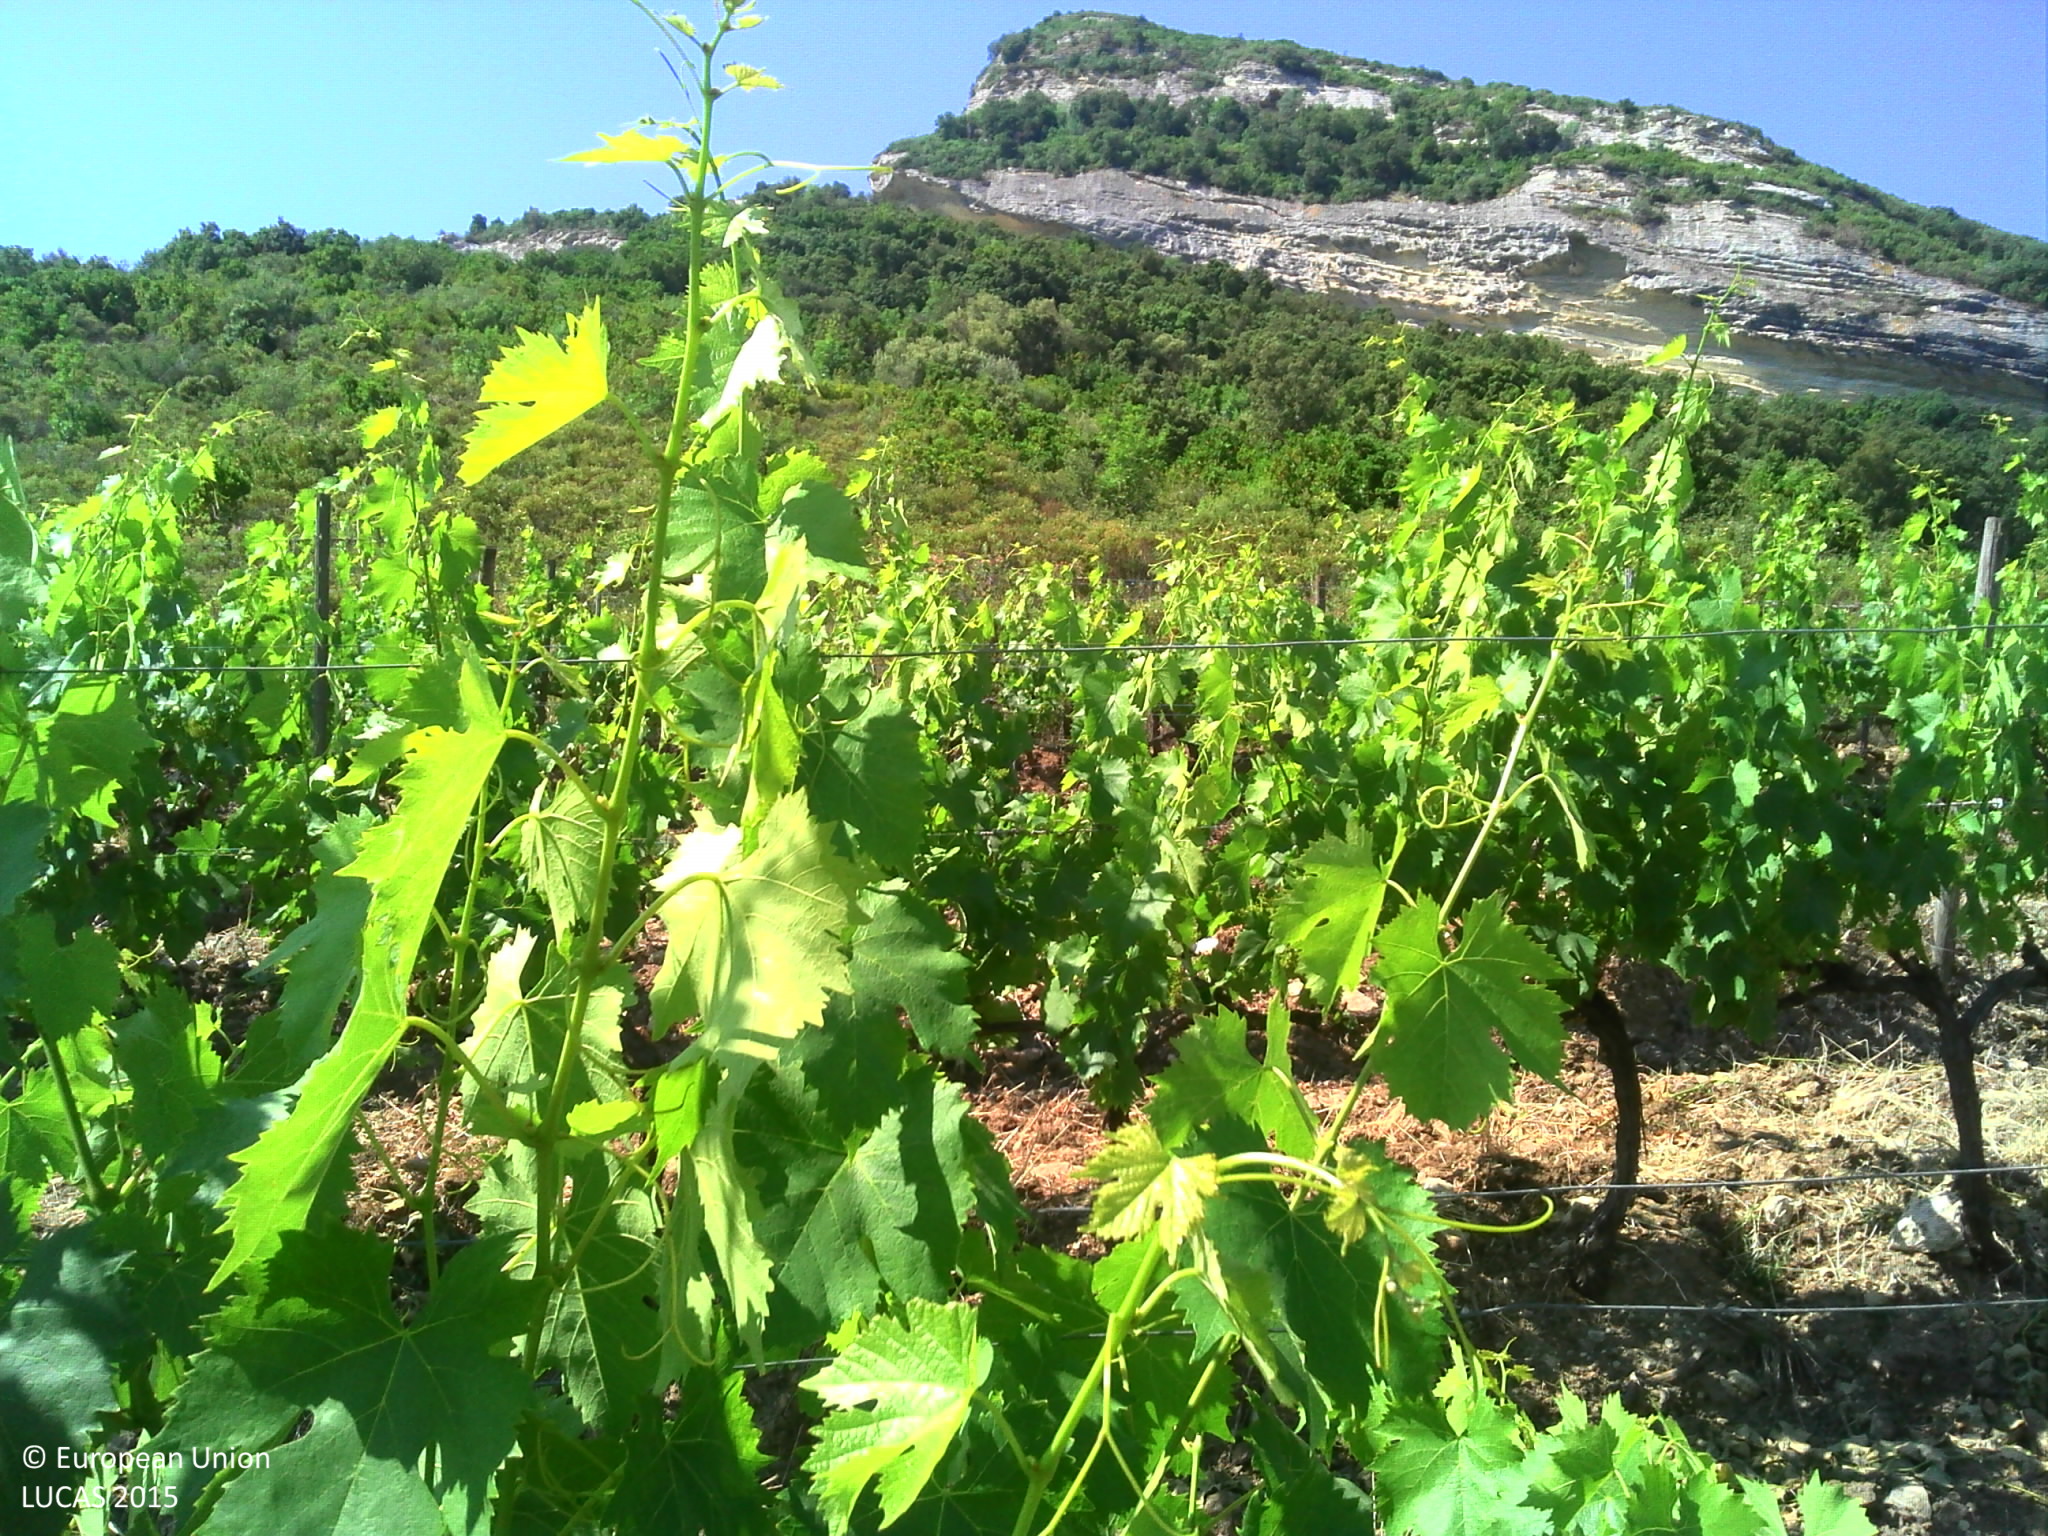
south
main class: Cropland
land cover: Vineyards
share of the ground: 50 - 75 %
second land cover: Other bare soil
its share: > 75 %
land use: Agriculture (excluding fallow land and kitchen gardens)
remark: Tilled/Sowed
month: June
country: FR
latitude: 42.6699
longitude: 9.3312
